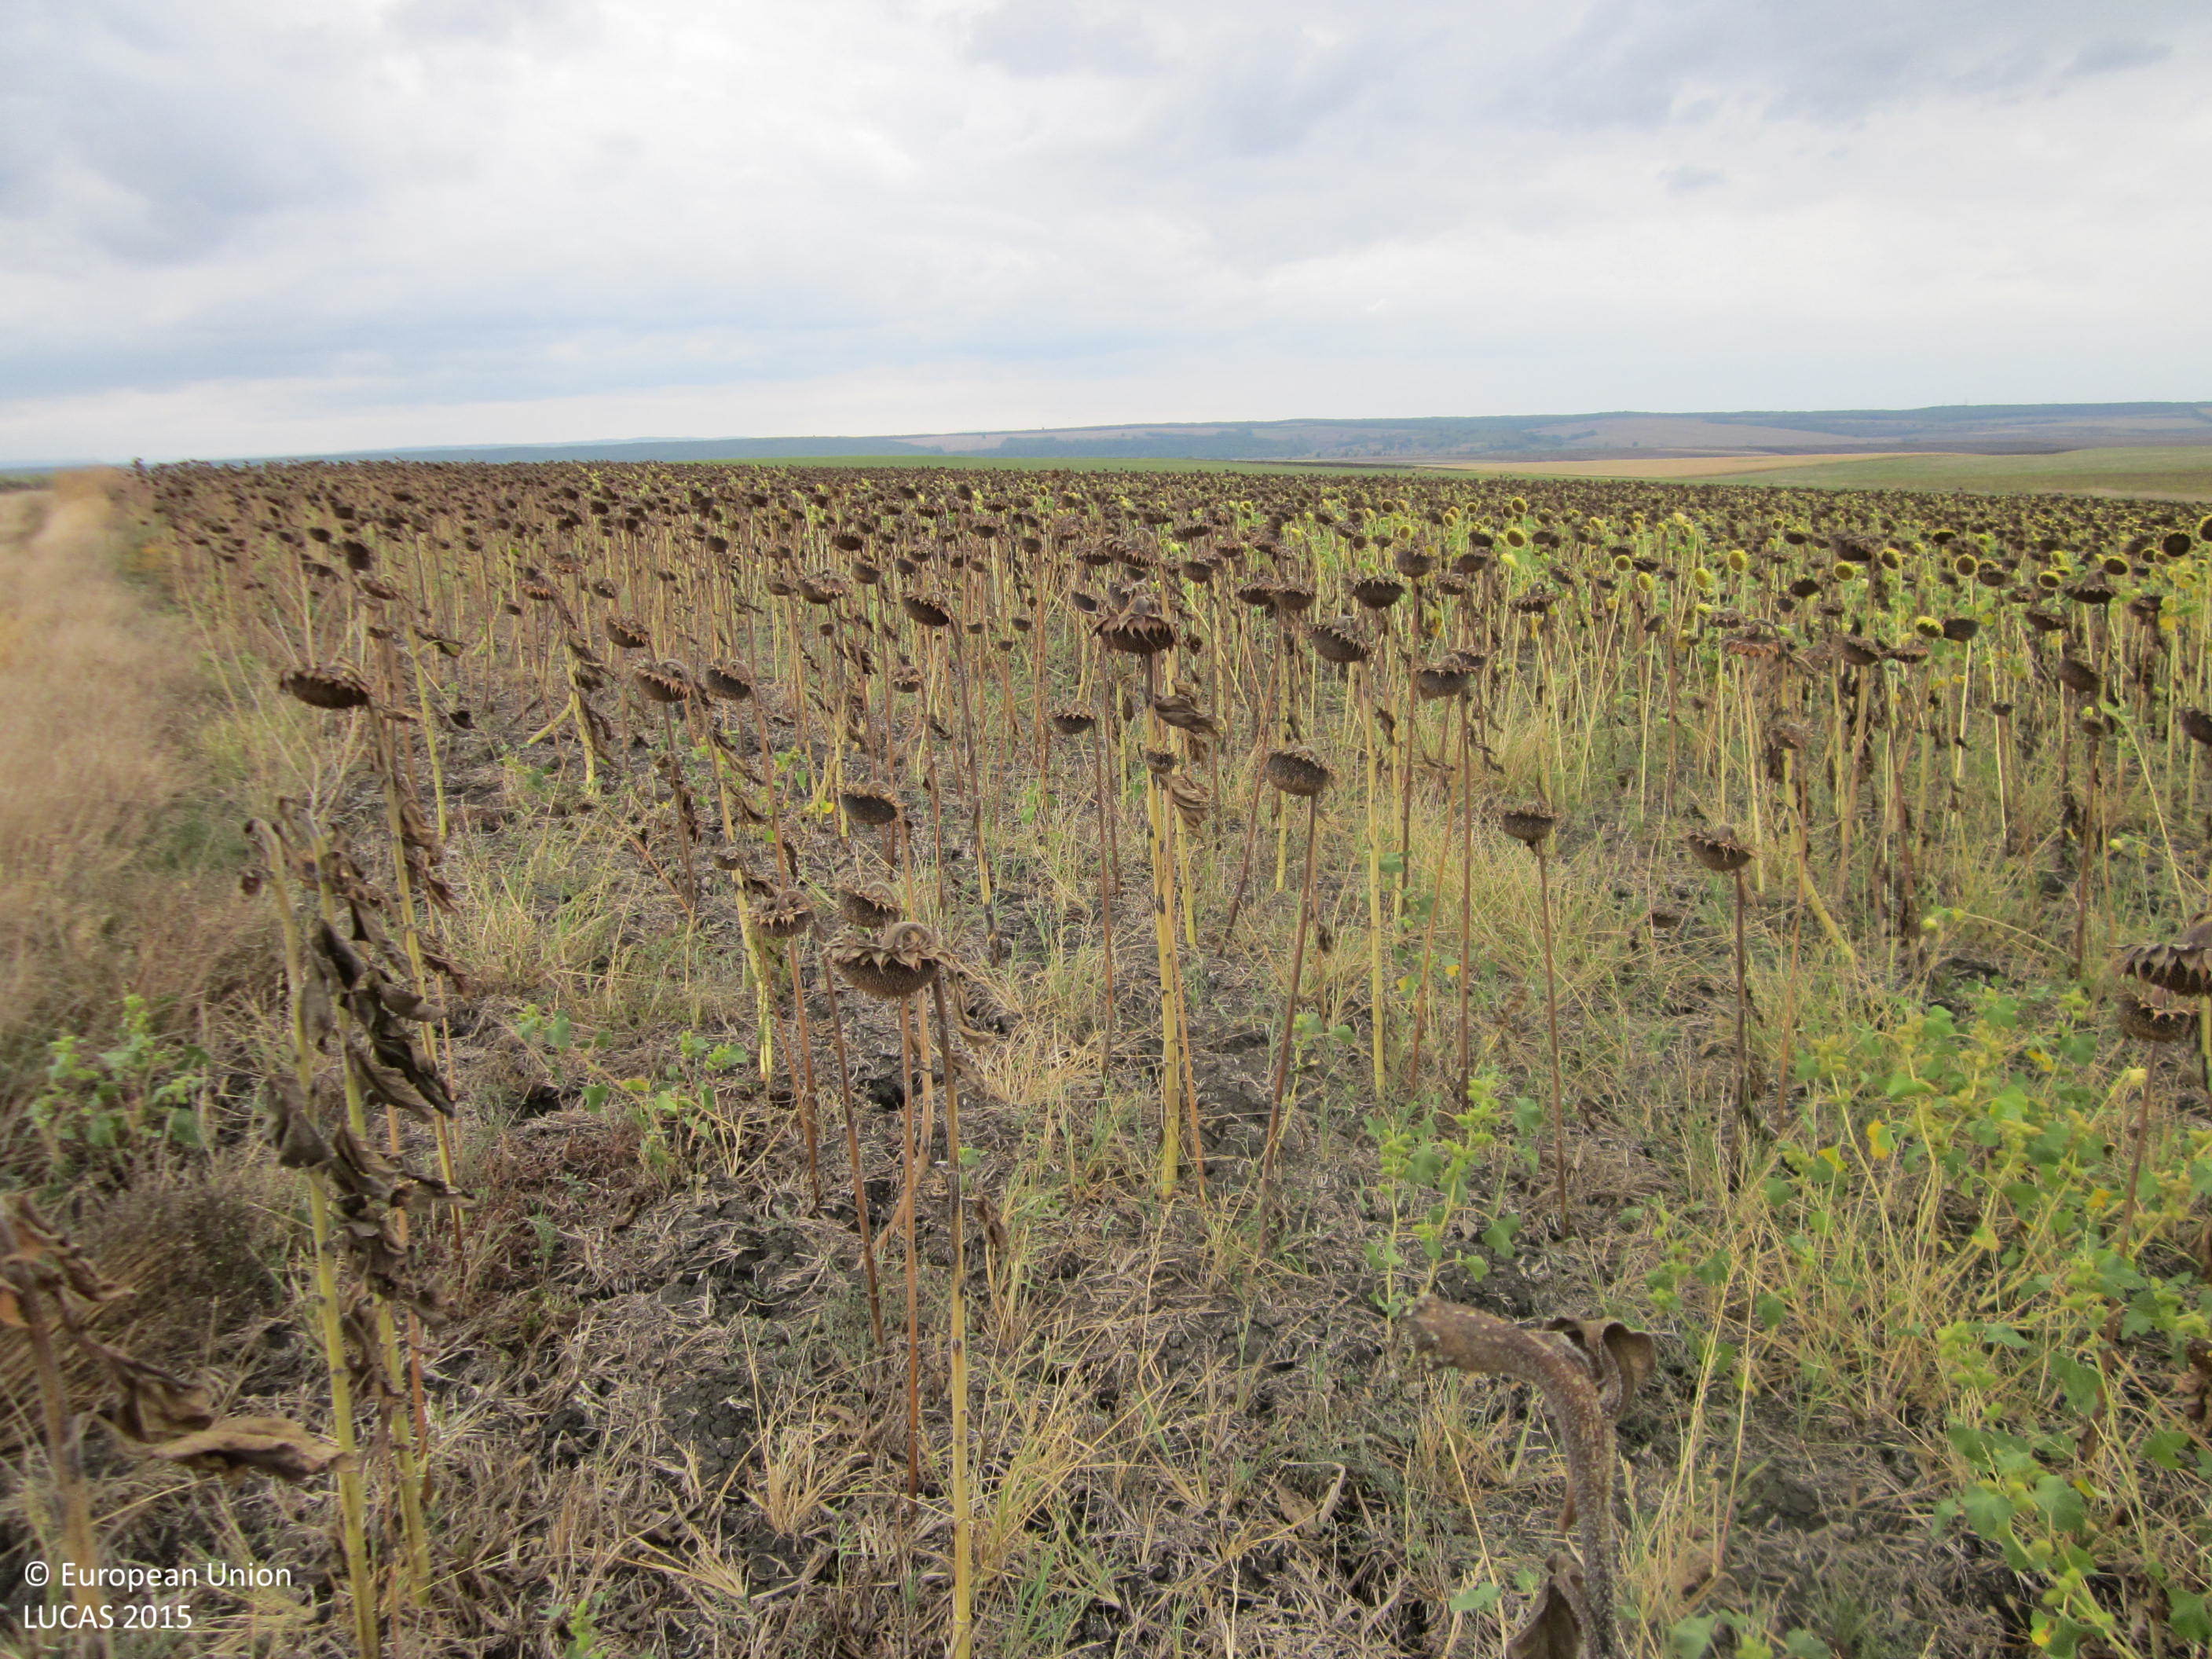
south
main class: Cropland
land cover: Sunflower
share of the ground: > 75 %
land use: Agriculture (excluding fallow land and kitchen gardens)
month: September
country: BG
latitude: 42.4734
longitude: 27.2239
